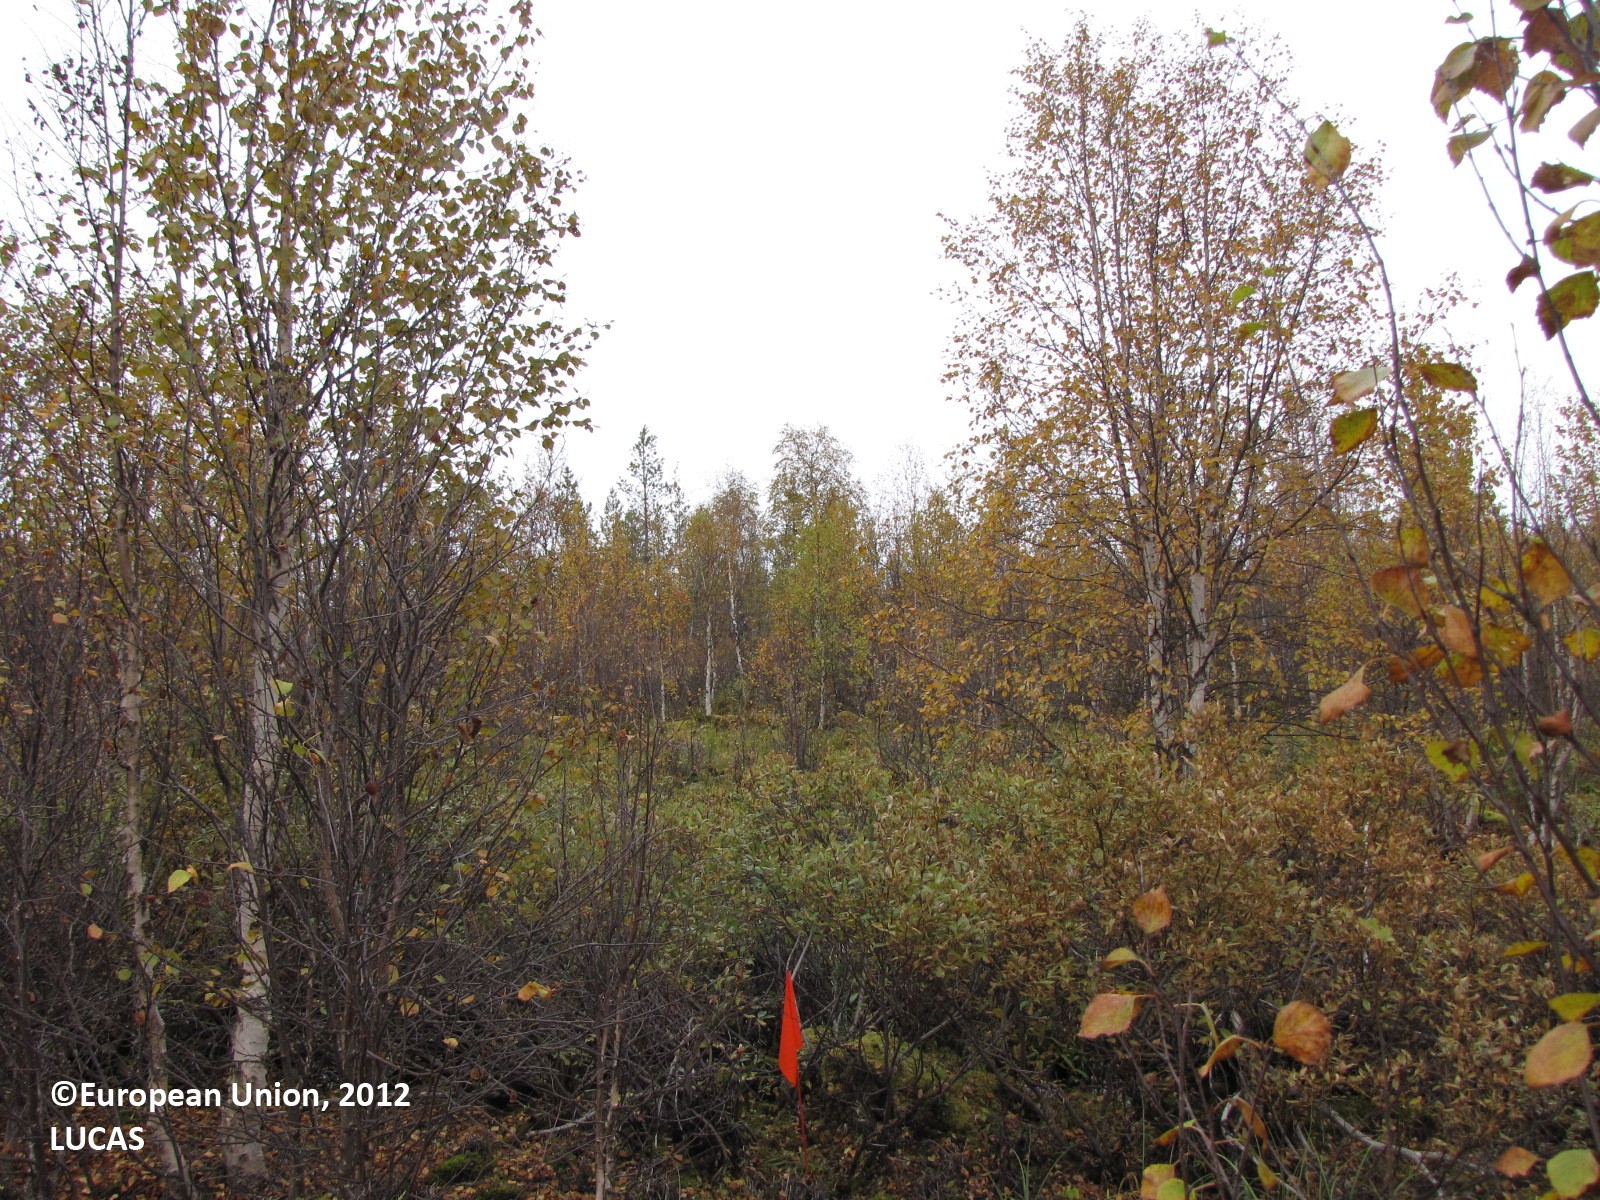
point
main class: Woodland
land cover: Broadleaved woodland
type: boreal forest
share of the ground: 25 - 50 %
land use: Forestry
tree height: > 5 m
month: September
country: FI
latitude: 67.3857
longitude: 23.7944
